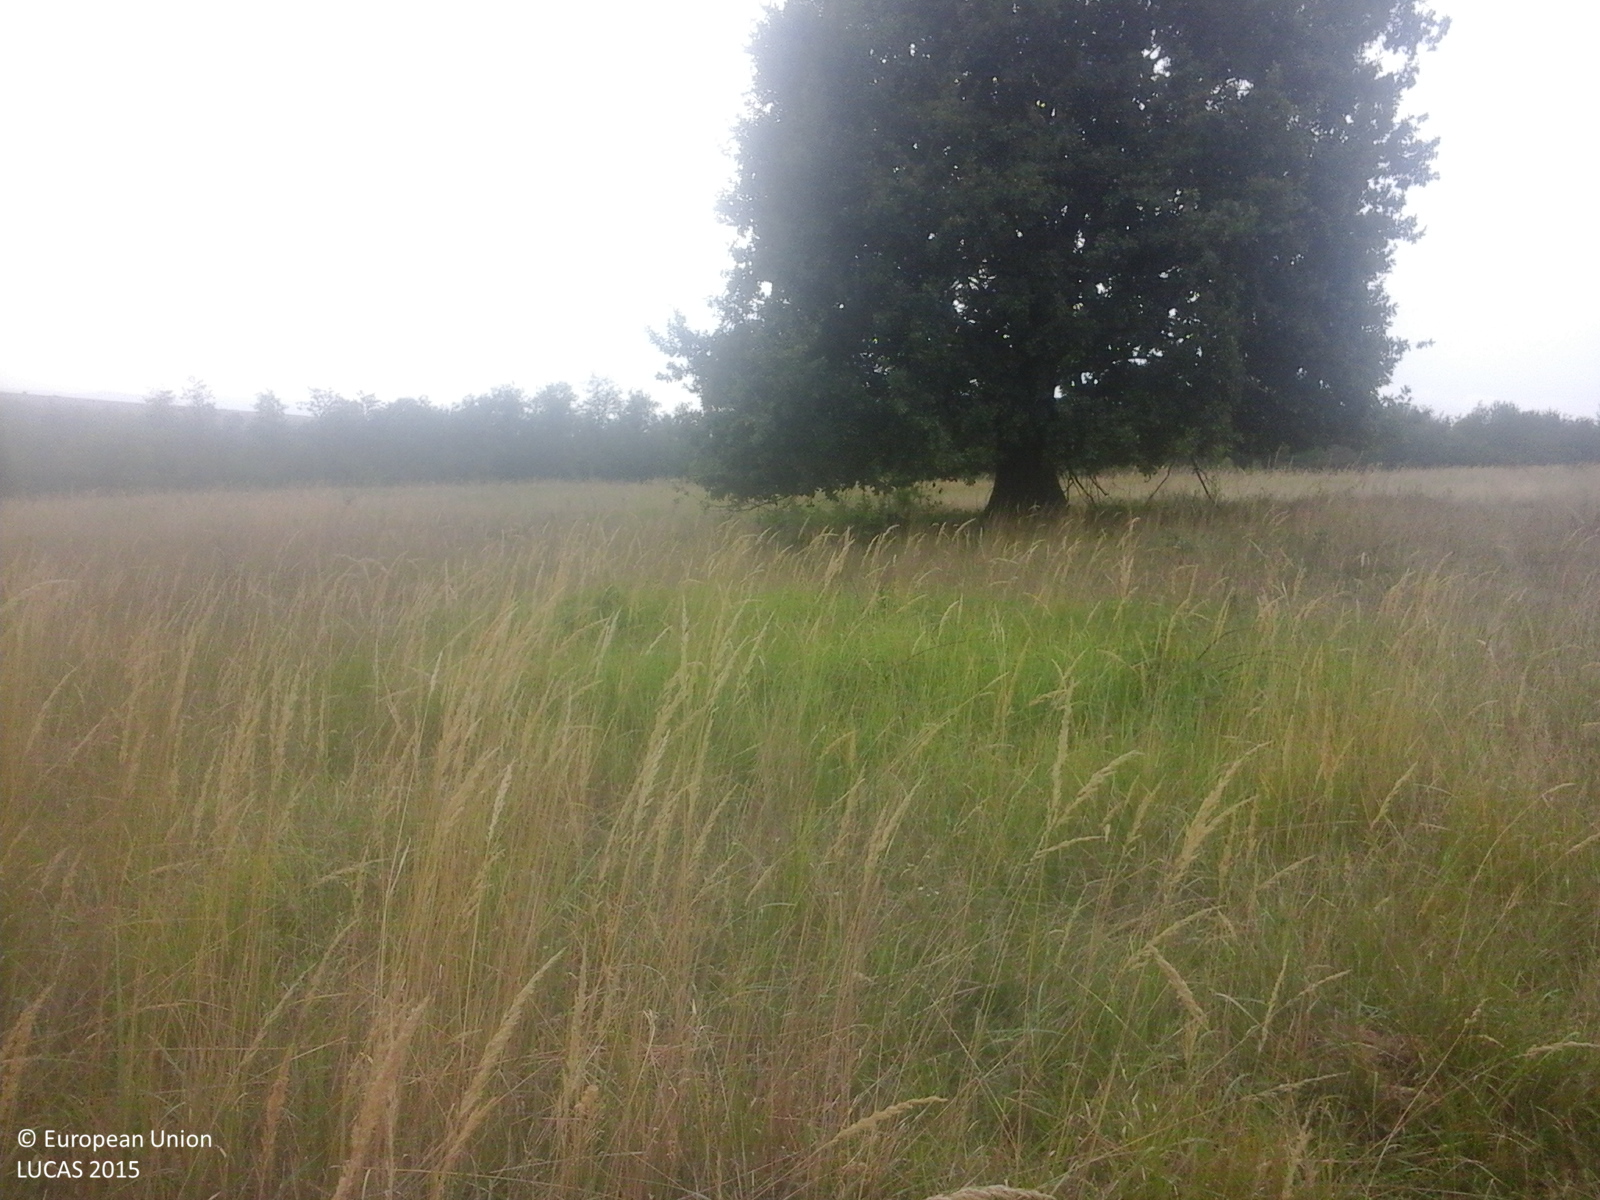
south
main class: Grassland
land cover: Grassland without tree/shrub cover
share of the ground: > 75 %
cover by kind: herbaceous plants 100 %
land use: Agriculture (excluding fallow land and kitchen gardens)
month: September
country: RO
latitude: 45.8811
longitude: 22.0894
